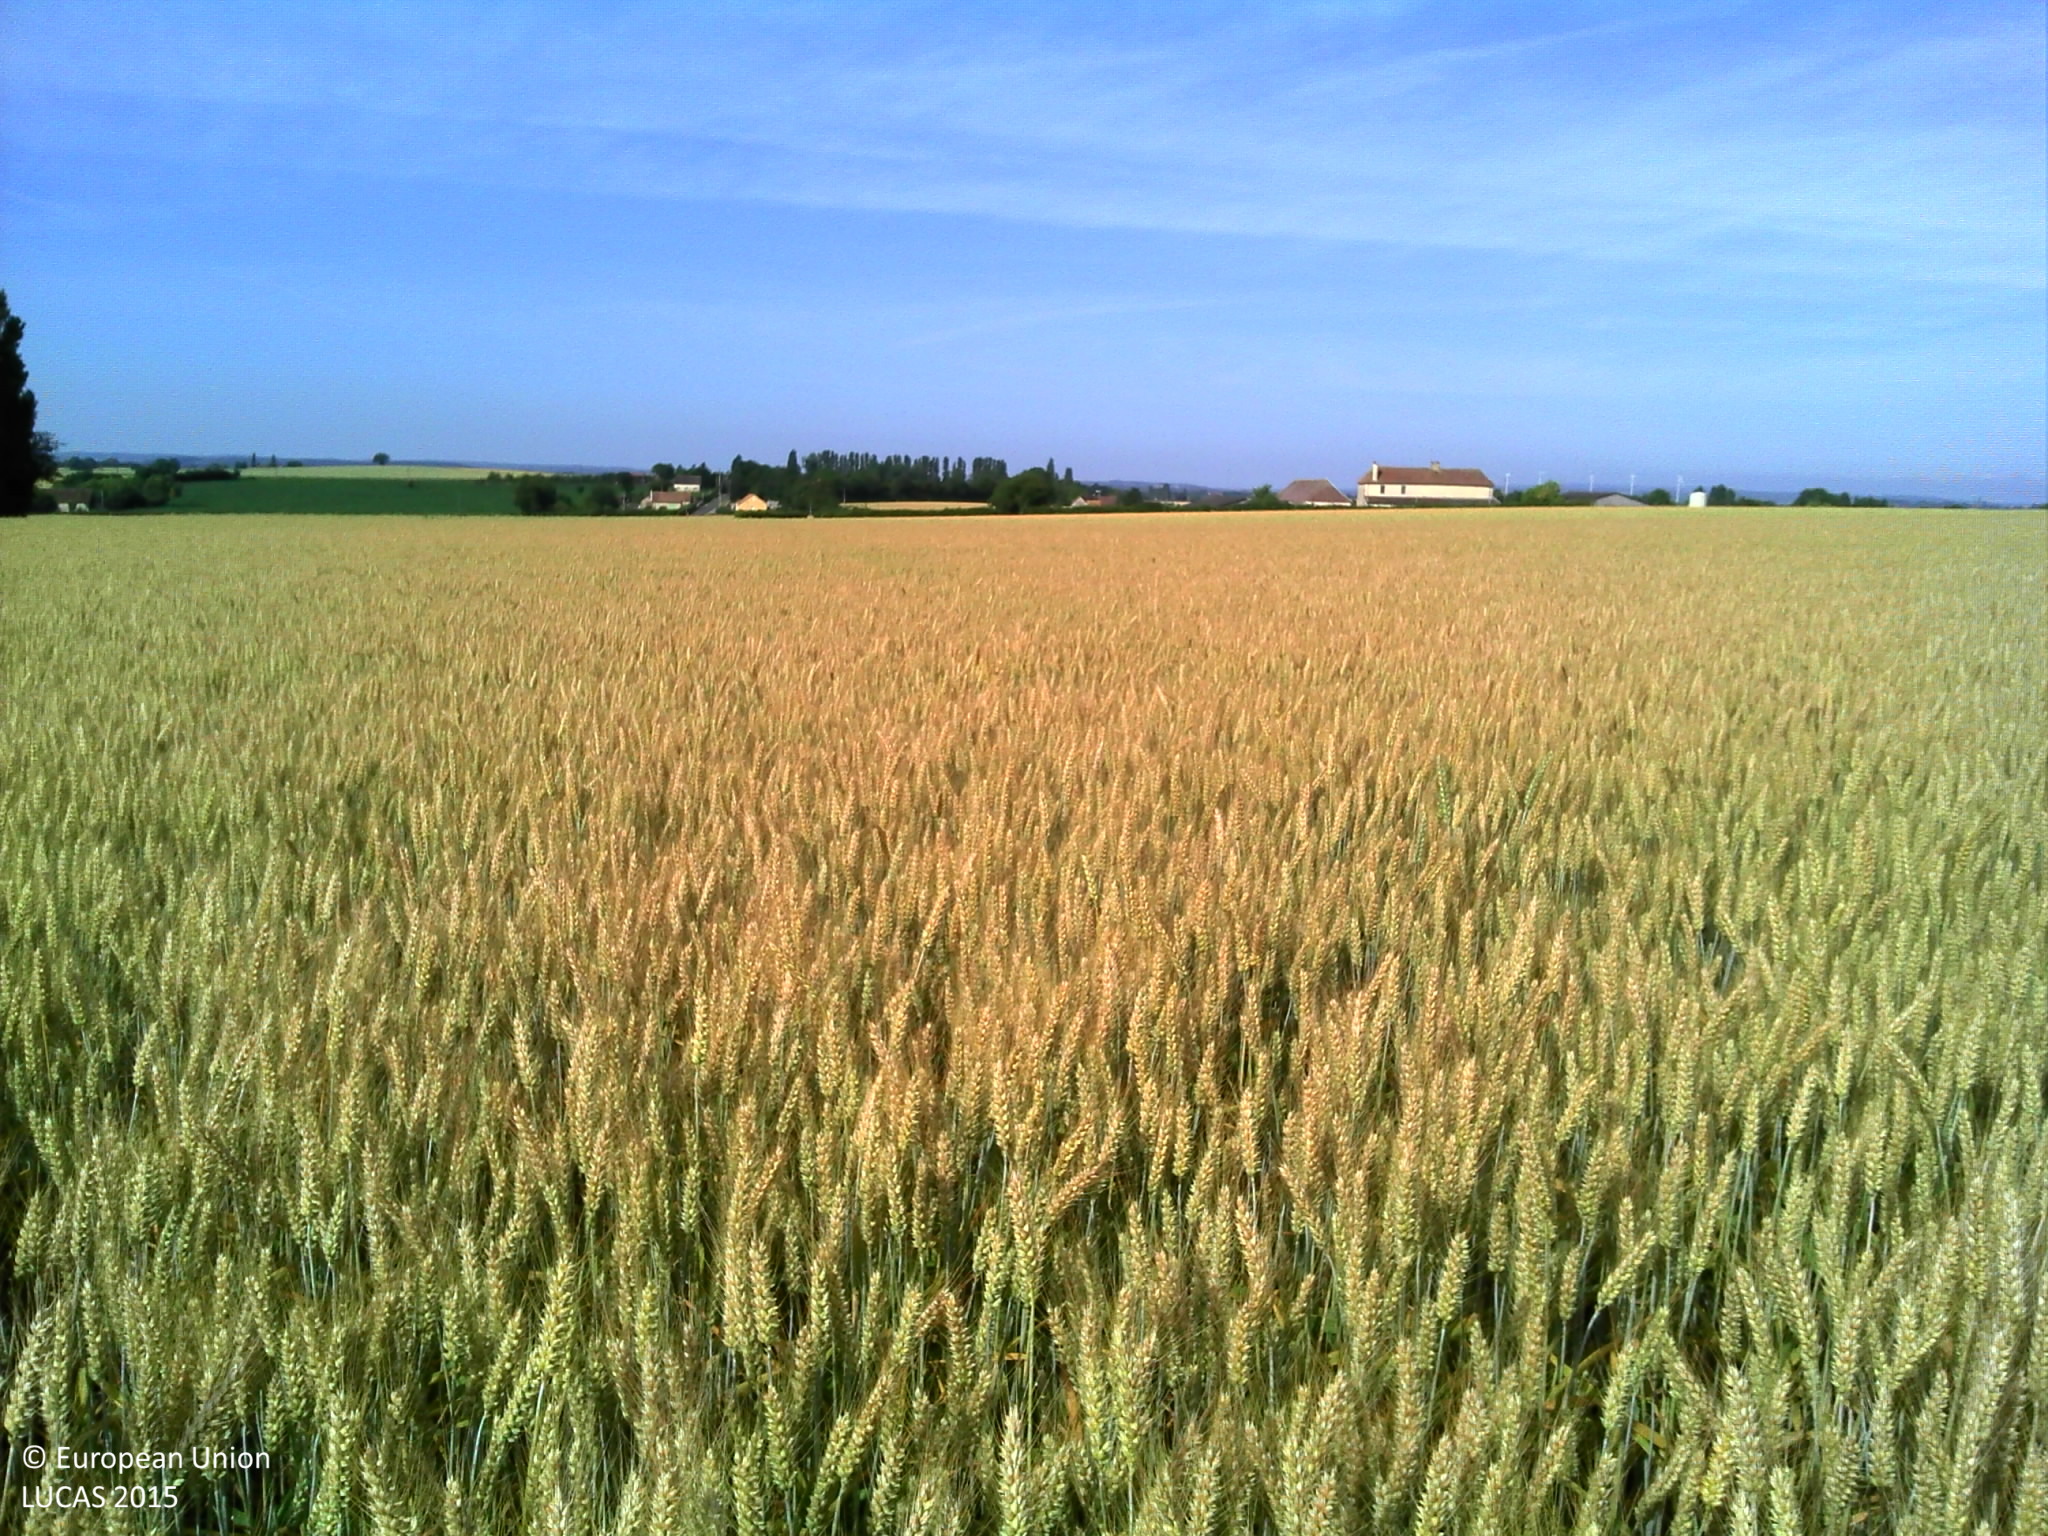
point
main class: Cropland
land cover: Triticale
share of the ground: > 75 %
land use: Agriculture (excluding fallow land and kitchen gardens)
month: June
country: FR
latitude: 48.2780
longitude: 0.2309
